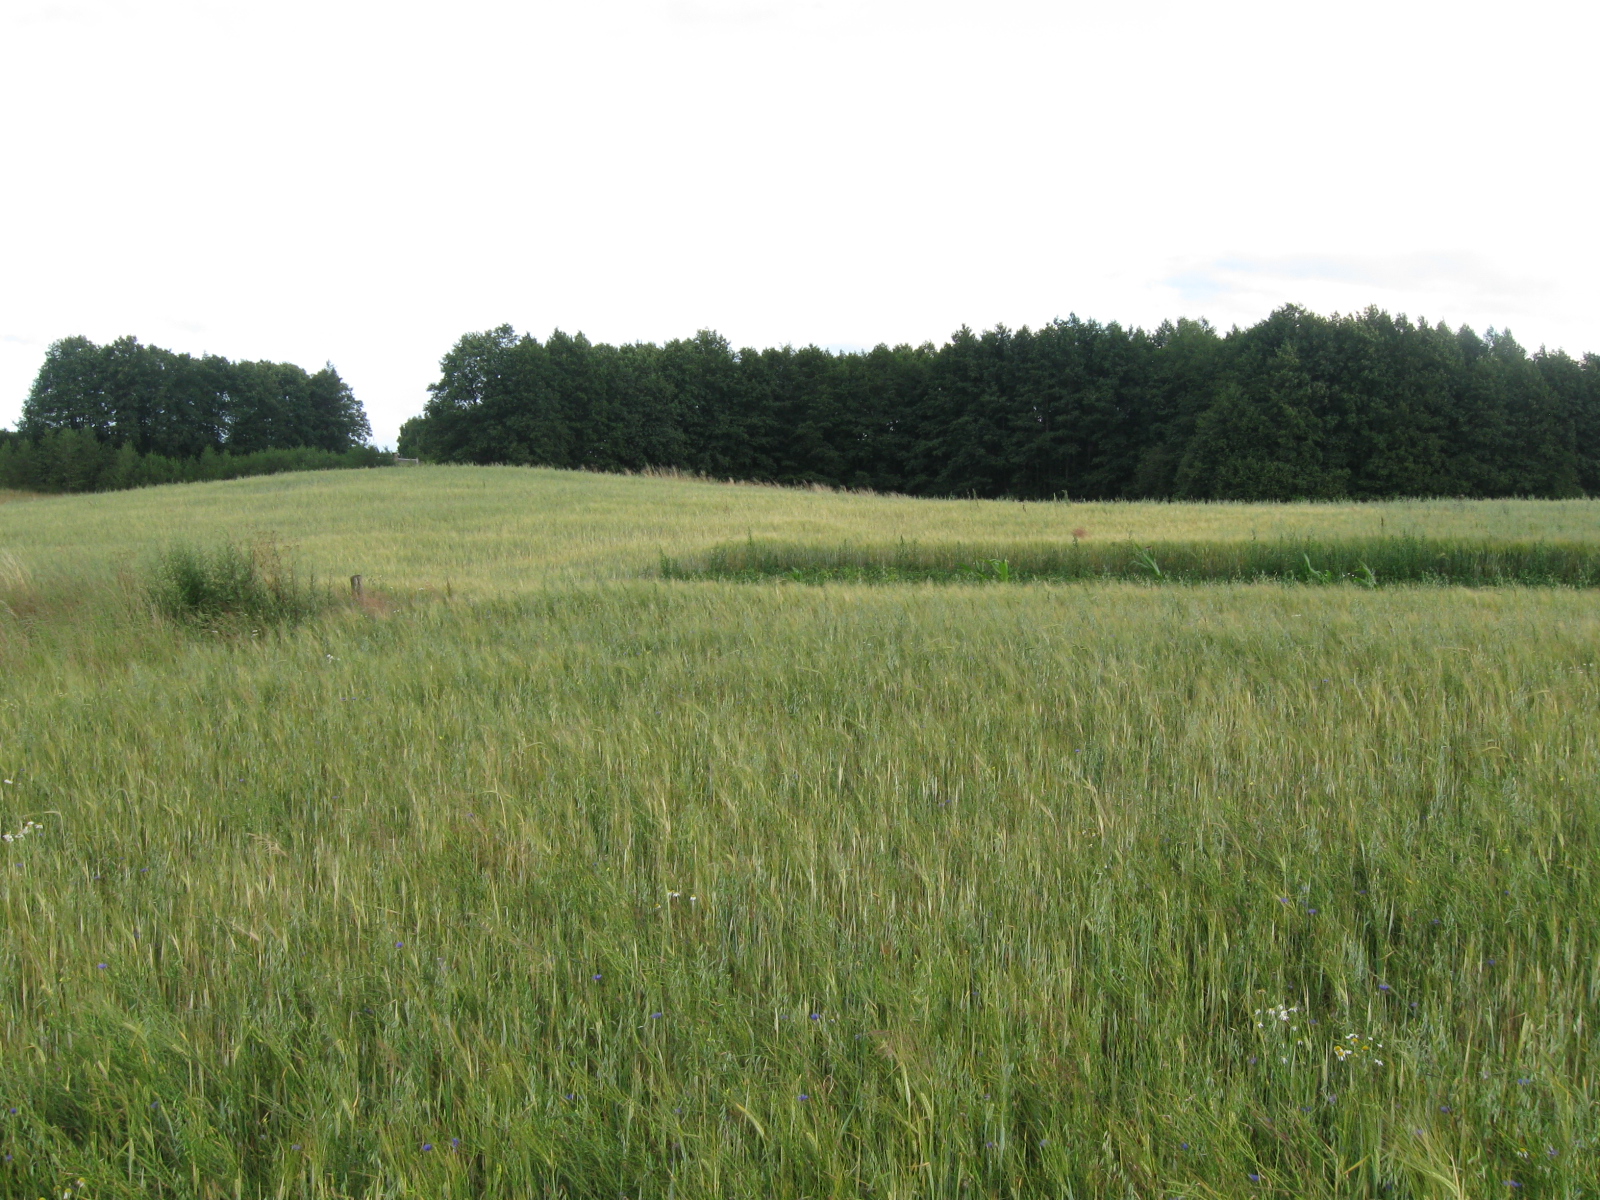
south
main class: Cropland
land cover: Barley
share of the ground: > 75 %
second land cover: Oats
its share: 10 - 25 %
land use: Agriculture (excluding fallow land and kitchen gardens)
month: July
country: LT
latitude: 54.3496
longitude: 24.3621
